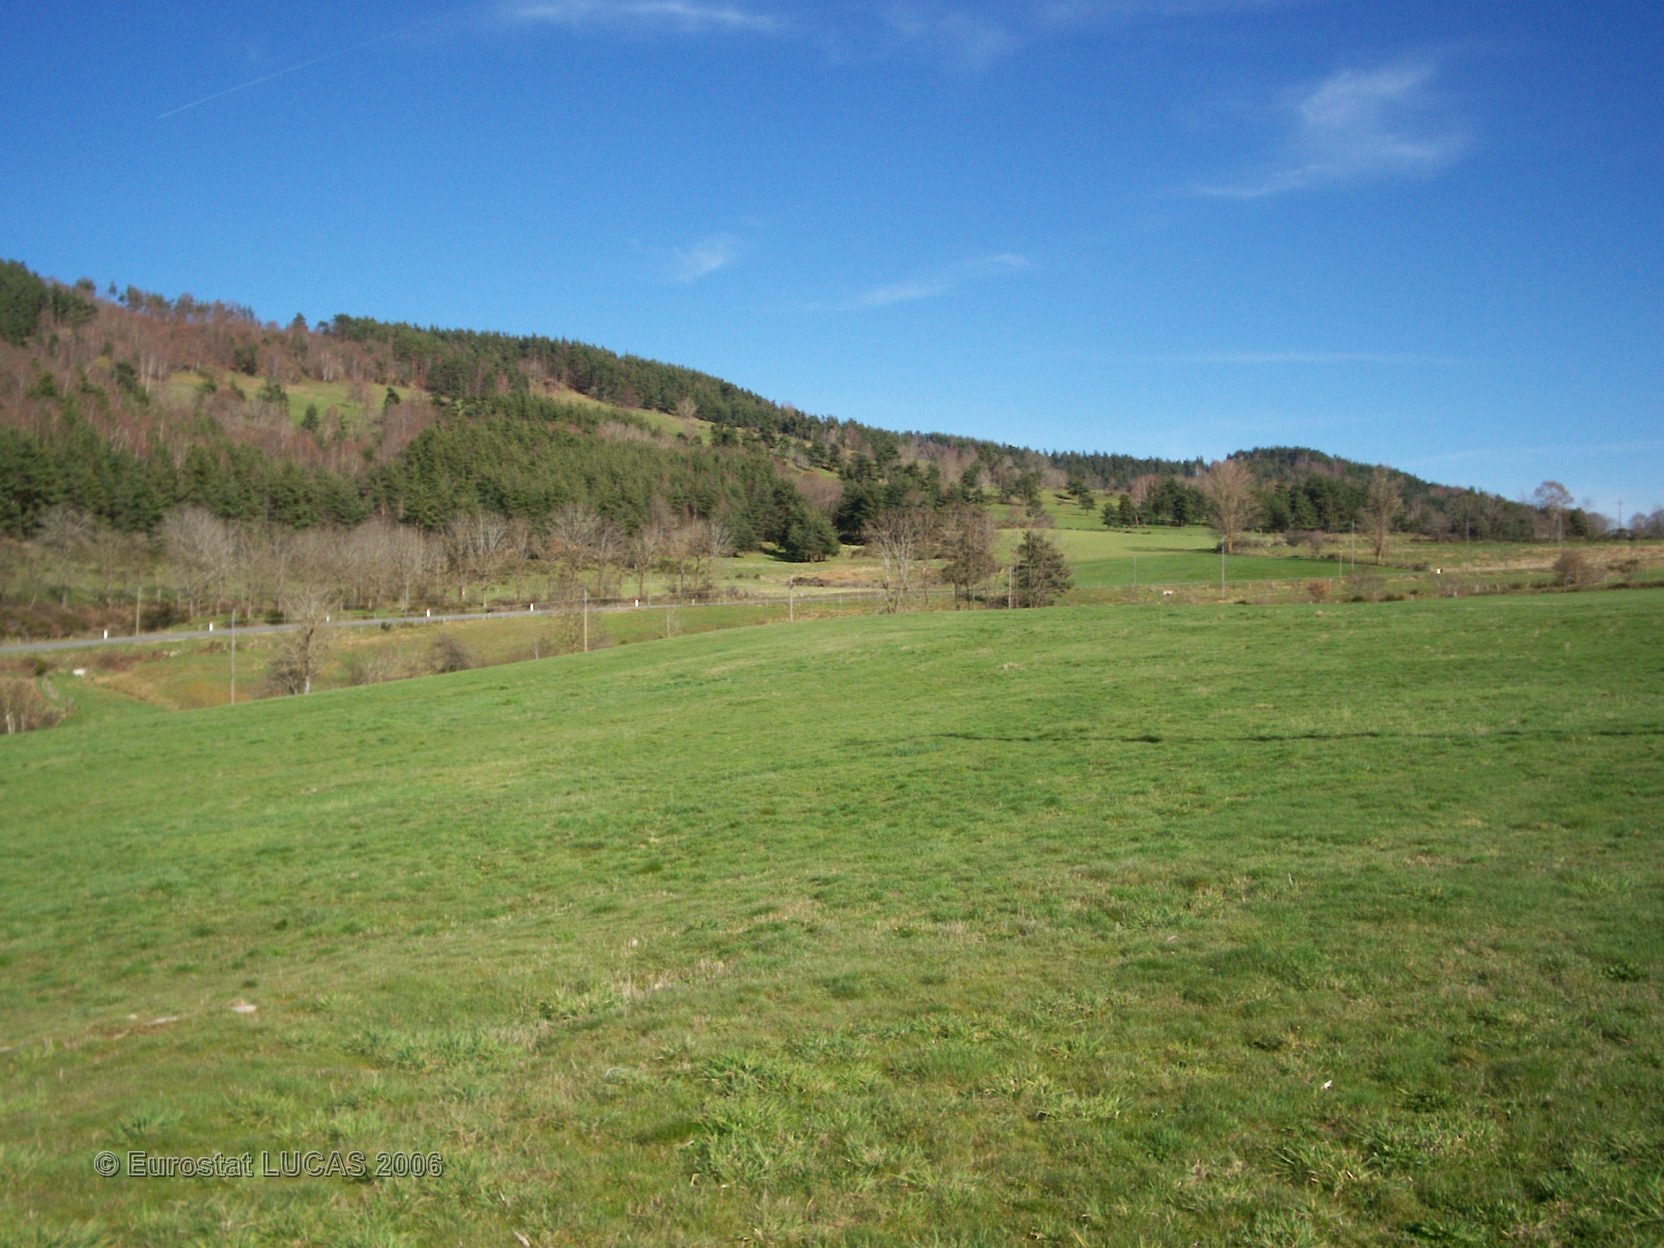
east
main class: Grassland
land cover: Grassland without tree/shrub cover
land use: Agriculture (excluding fallow land and kitchen gardens)
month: April
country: FR
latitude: 44.8434
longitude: 3.3617
